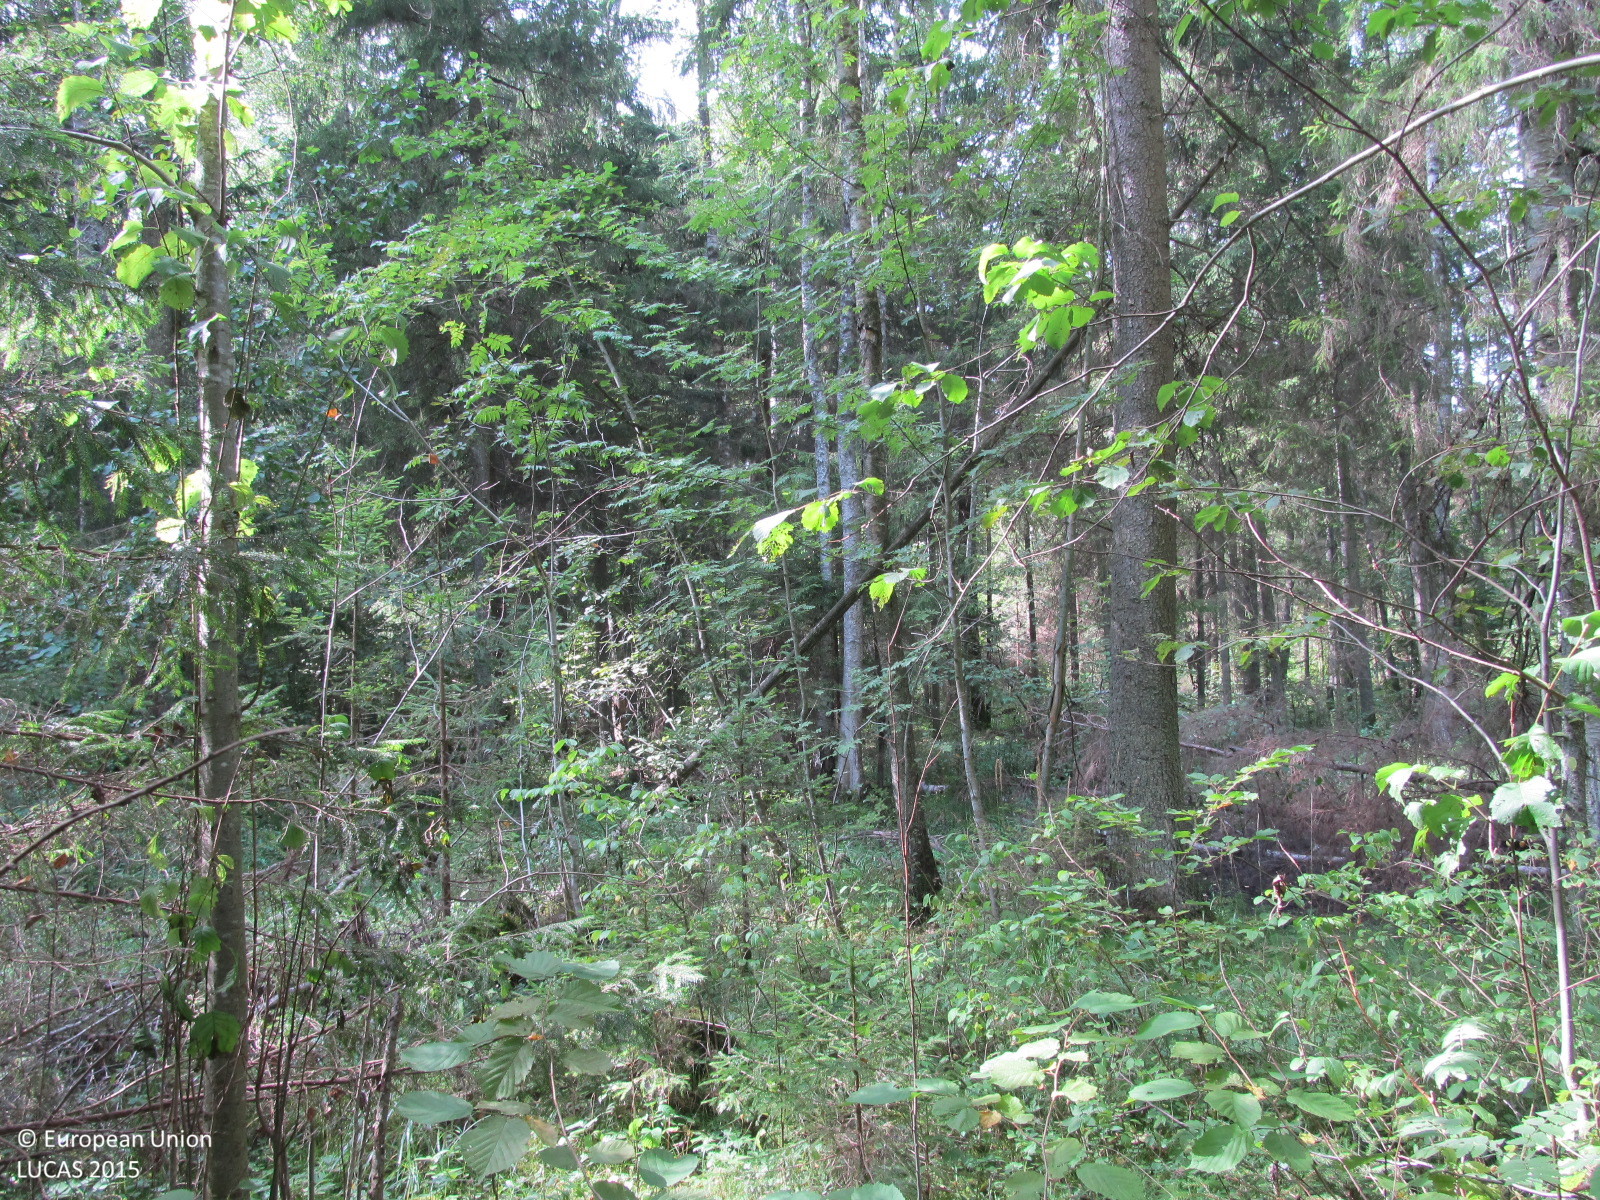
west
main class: Woodland
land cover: Spruce dominated mixed woodland
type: hemiboreal forest and nemoral coniferous forest and mixed broadleaved-coniferous forest
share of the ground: > 75 %
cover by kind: coniferous forest trees 45 %, broadleaved forest trees 40 %, herbaceous plants 10 %, shrubs 5 %
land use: Forestry
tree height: > 5 m
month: August
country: LT
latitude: 55.7782
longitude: 22.9988
